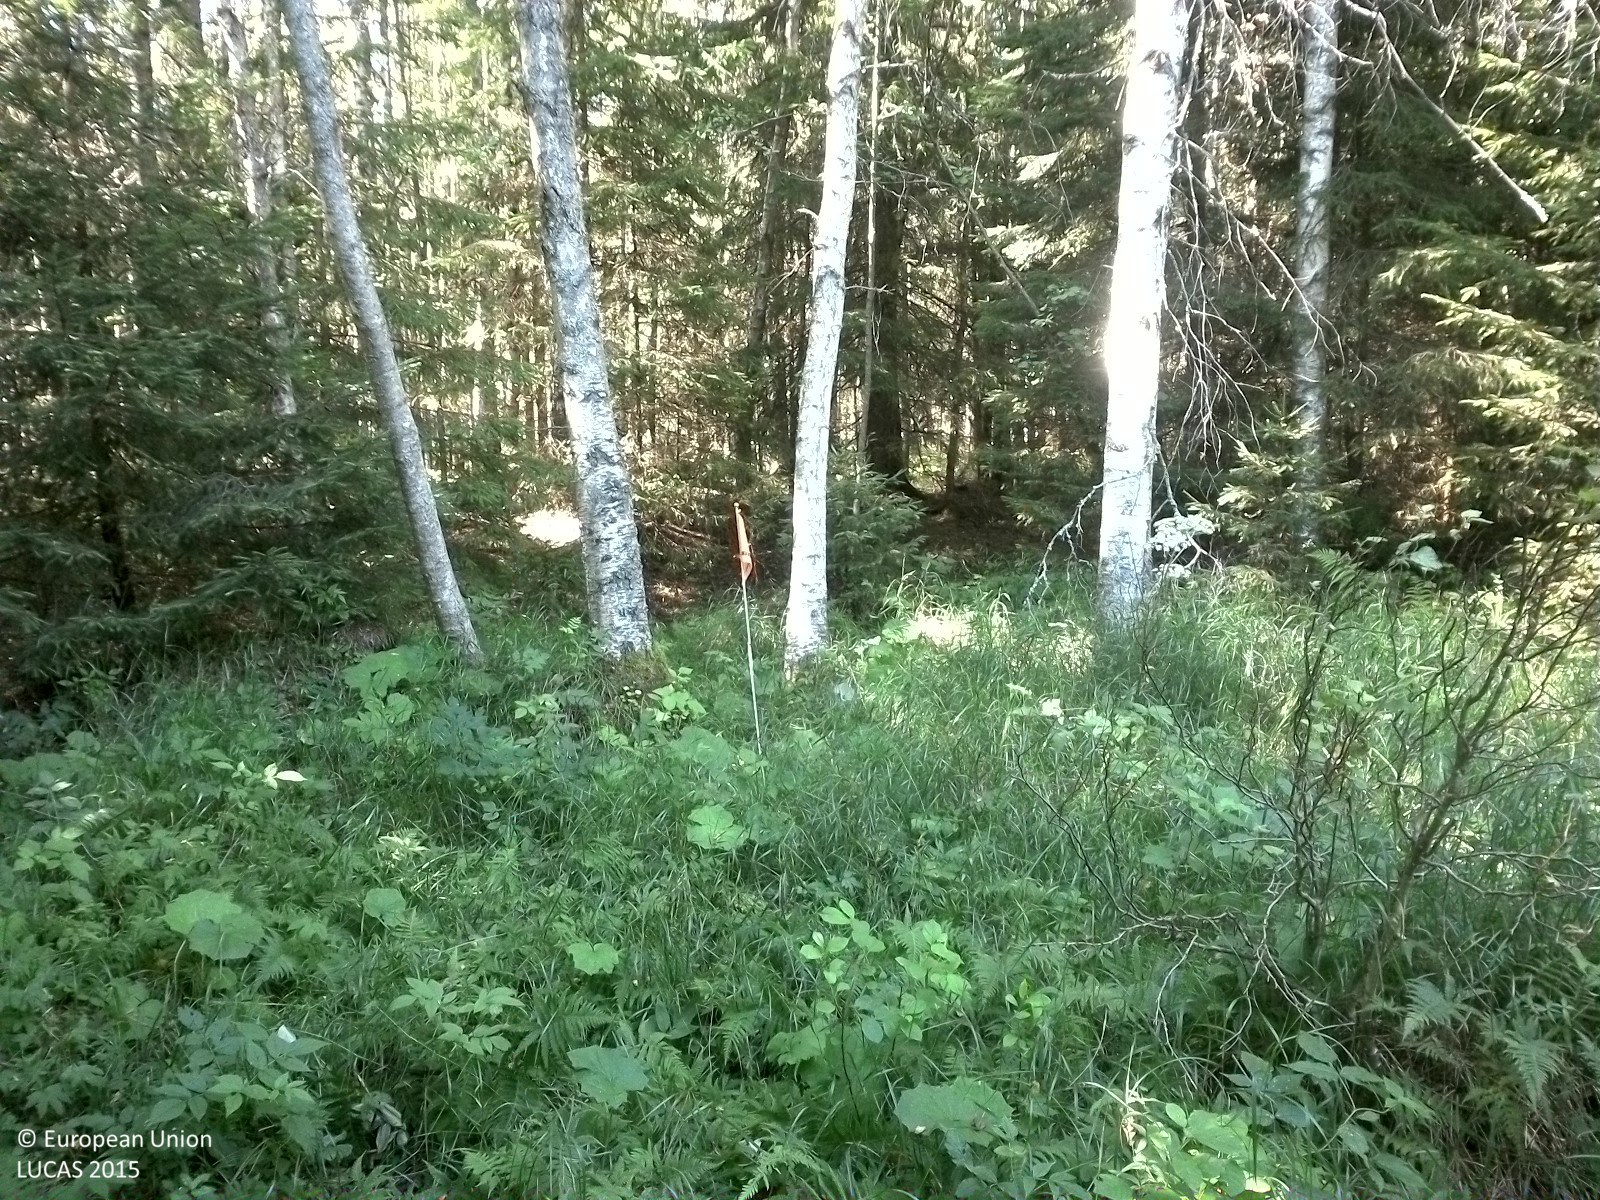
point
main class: Woodland
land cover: Spruce dominated mixed woodland
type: boreal forest
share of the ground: 50 - 75 %
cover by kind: shrubs 45 %, coniferous forest trees 30 %, broadleaved forest trees 25 %
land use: Forestry
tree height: > 5 m
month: August
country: SE
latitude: 59.2318
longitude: 14.8462
